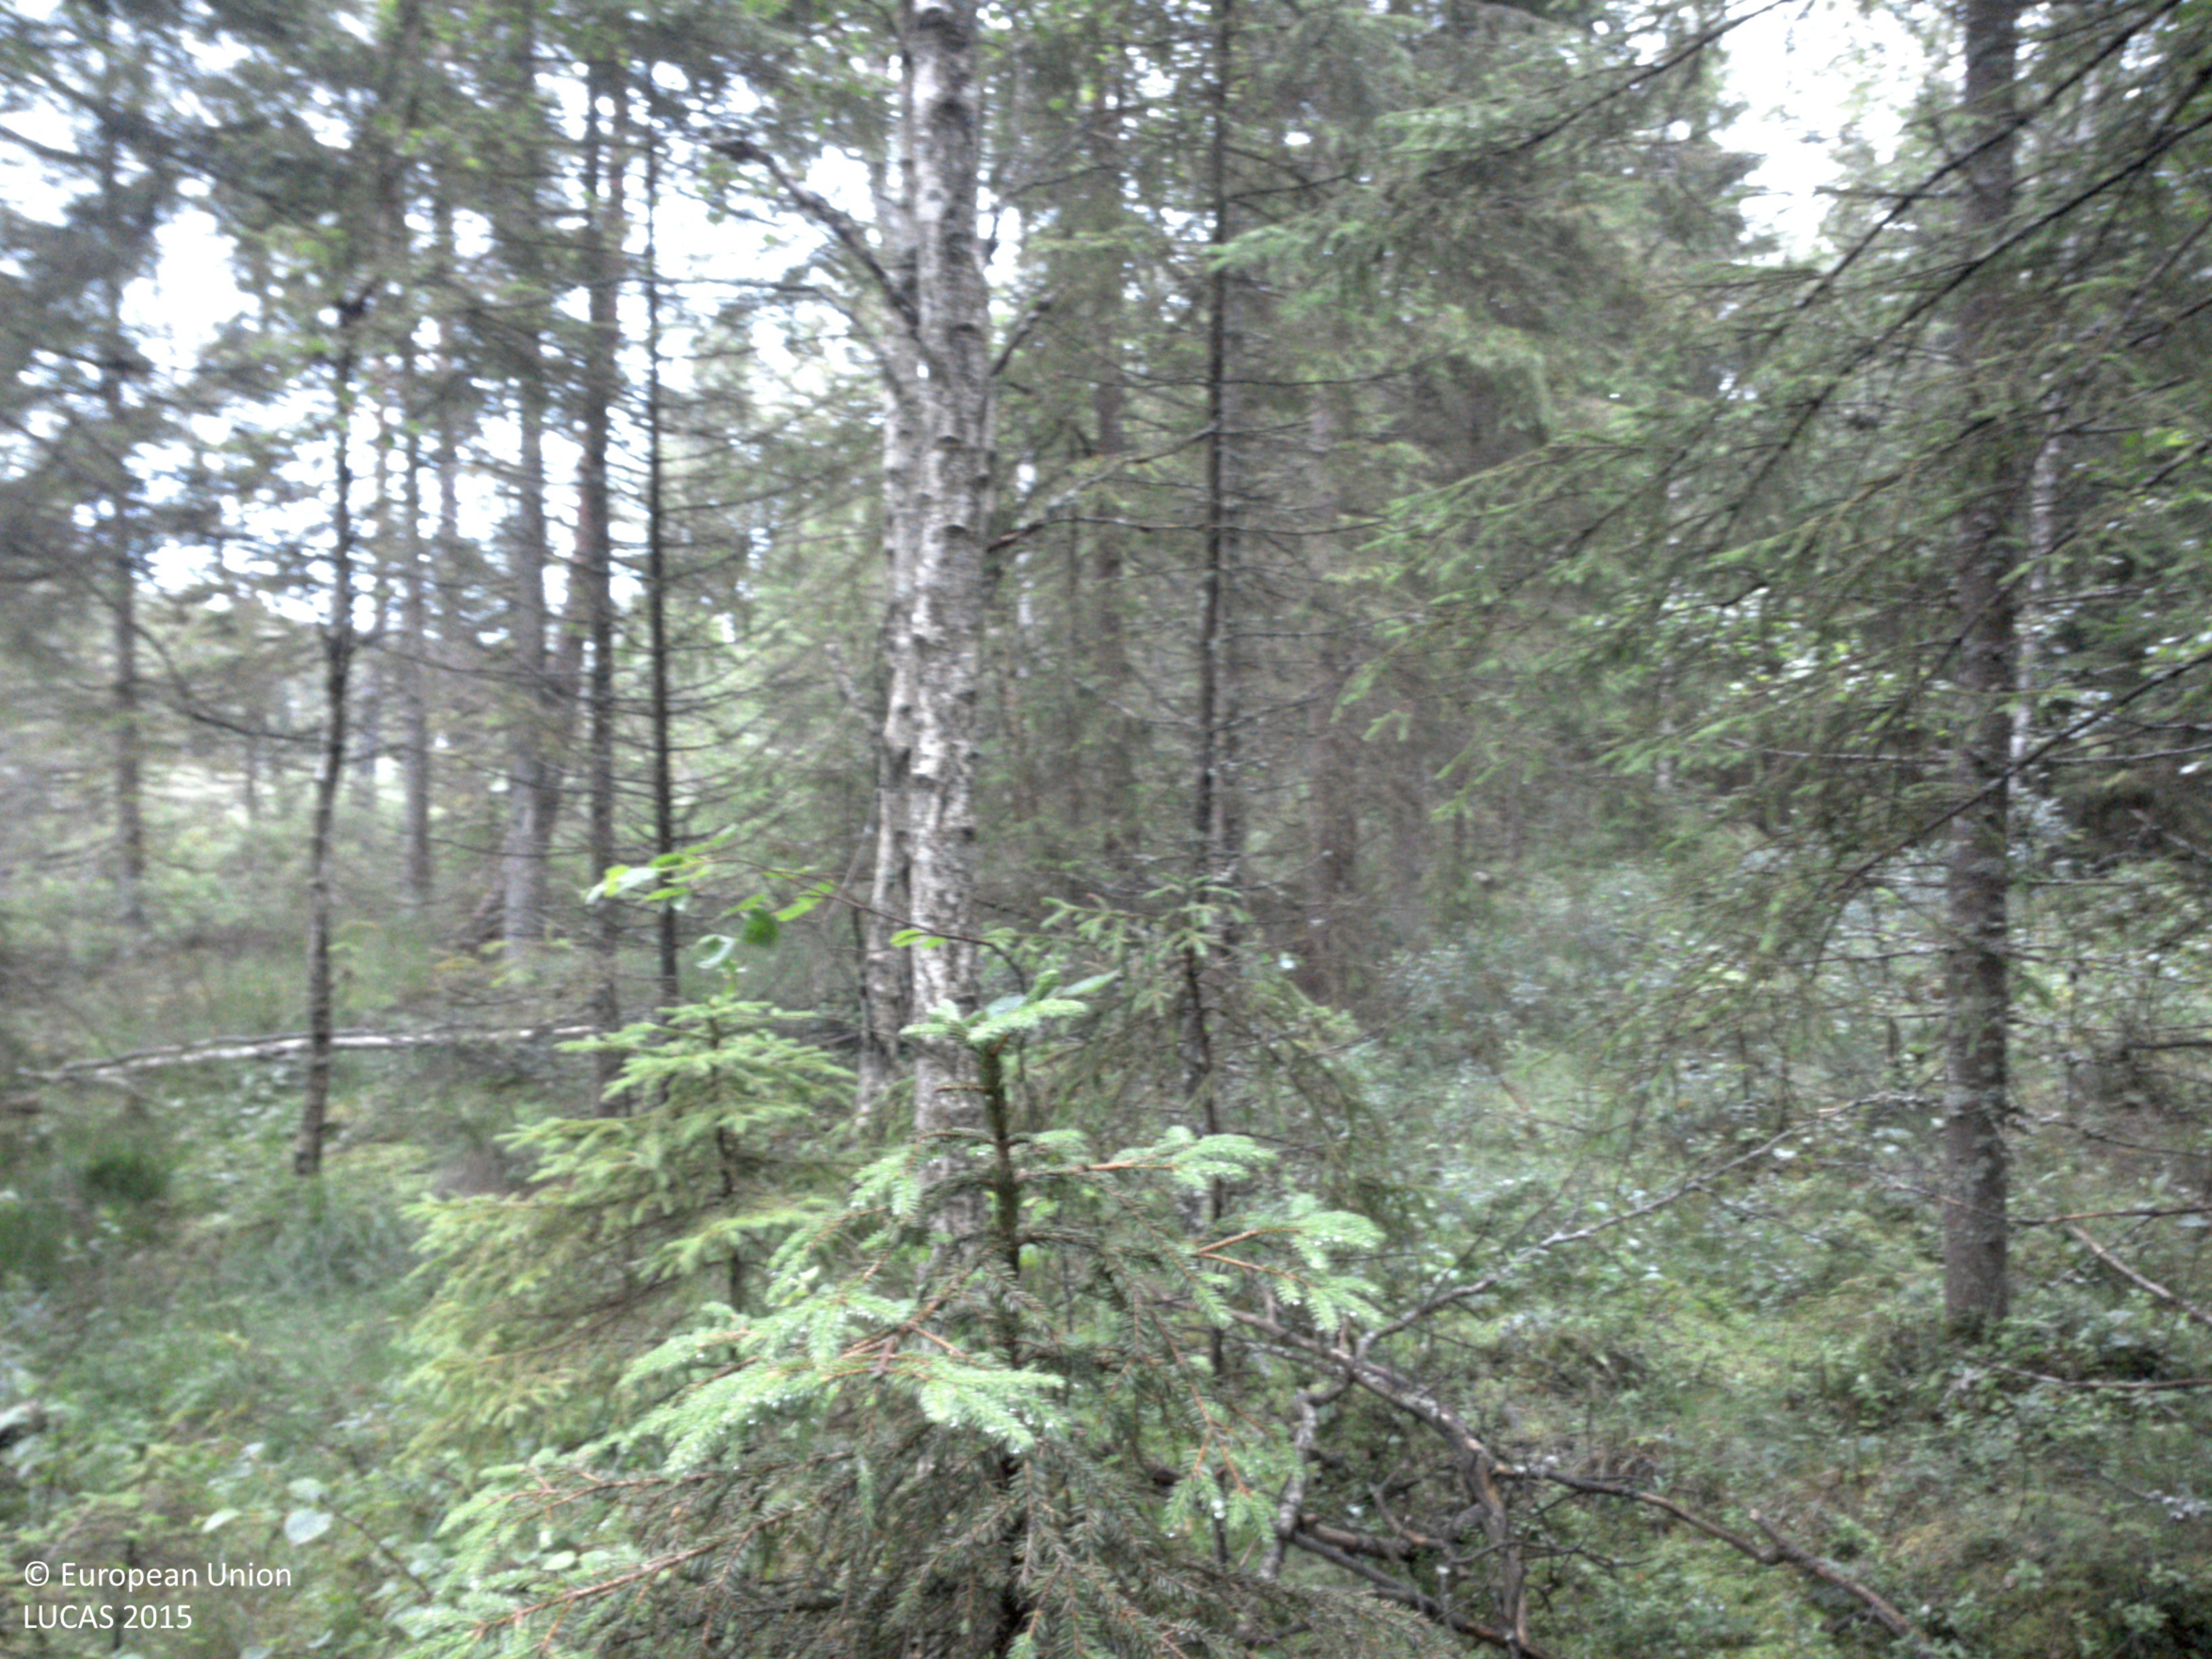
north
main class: Woodland
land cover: Spruce dominated mixed woodland
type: boreal forest
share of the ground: 50 - 75 %
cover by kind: coniferous forest trees 40 %, broadleaved forest trees 20 %, herbaceous plants 20 %, lichens and mosses 20 %
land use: Forestry
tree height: > 5 m
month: July
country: SE
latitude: 58.7092
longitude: 11.9463
